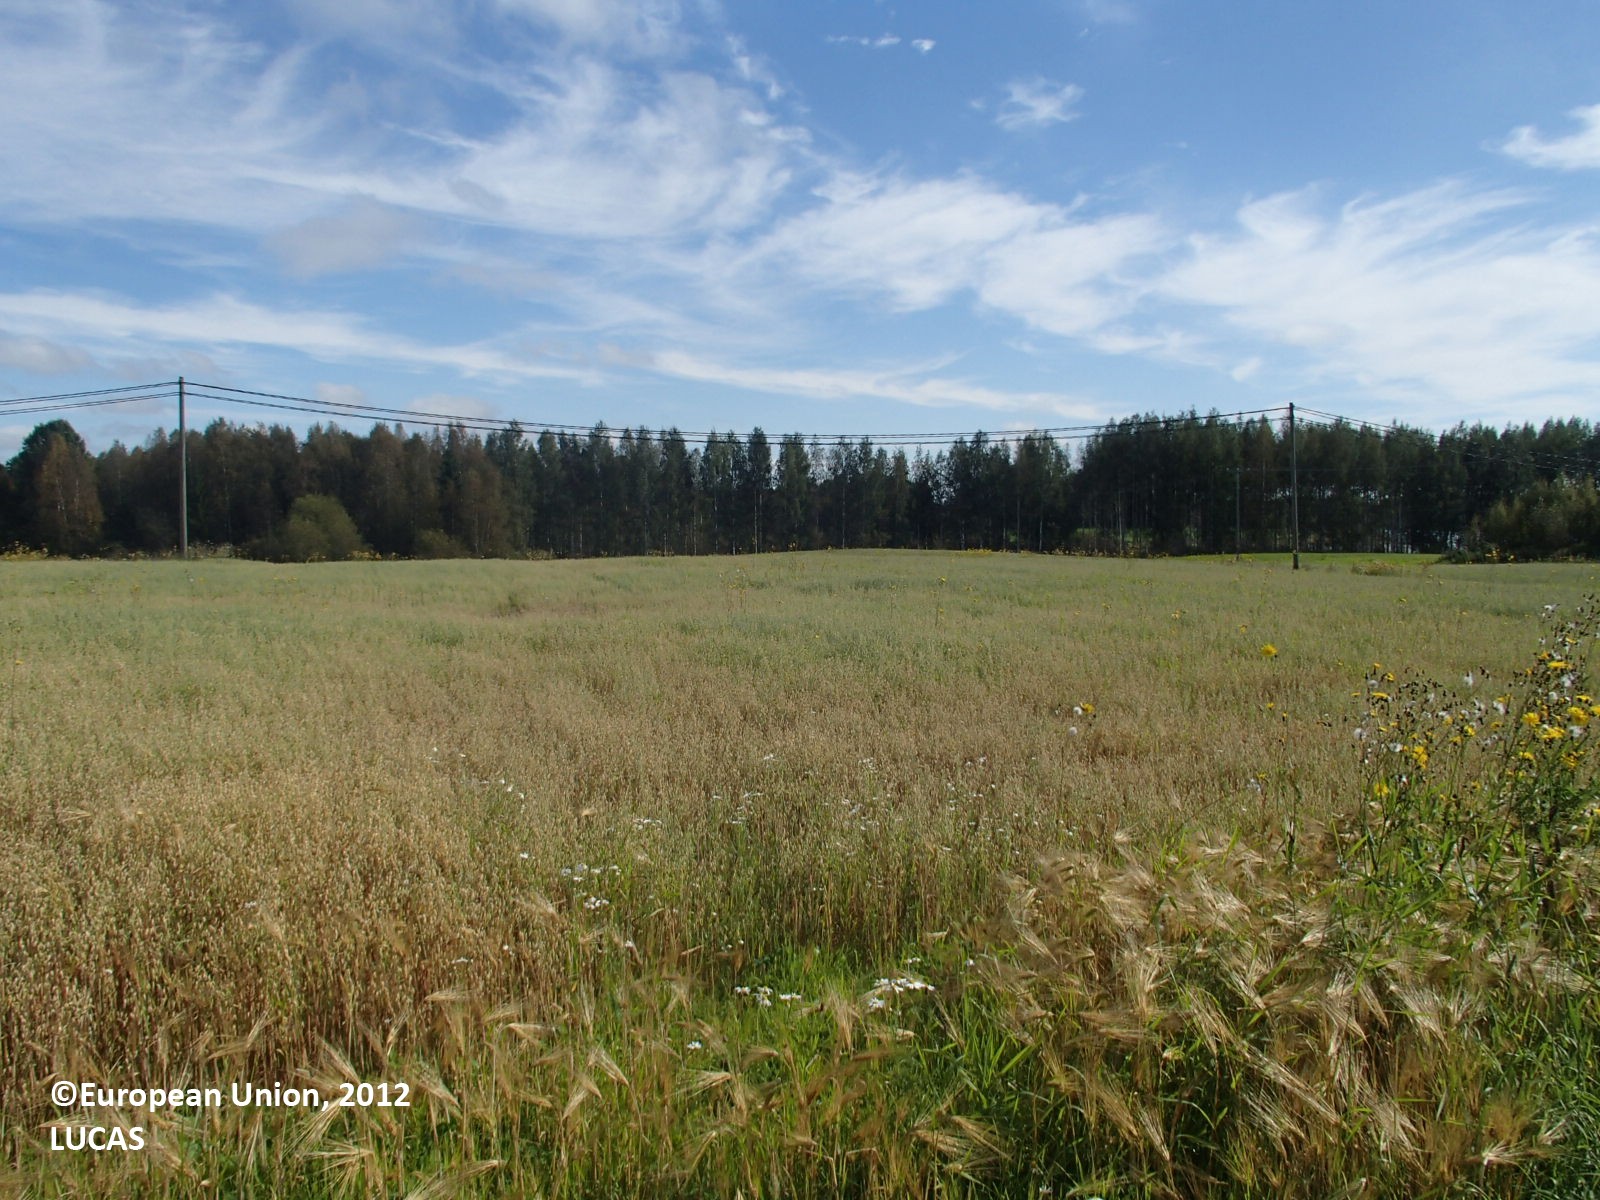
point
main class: Cropland
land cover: Oats
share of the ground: > 75 %
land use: Agriculture (excluding fallow land and kitchen gardens)
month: August
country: FI
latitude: 63.6031
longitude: 27.1389
